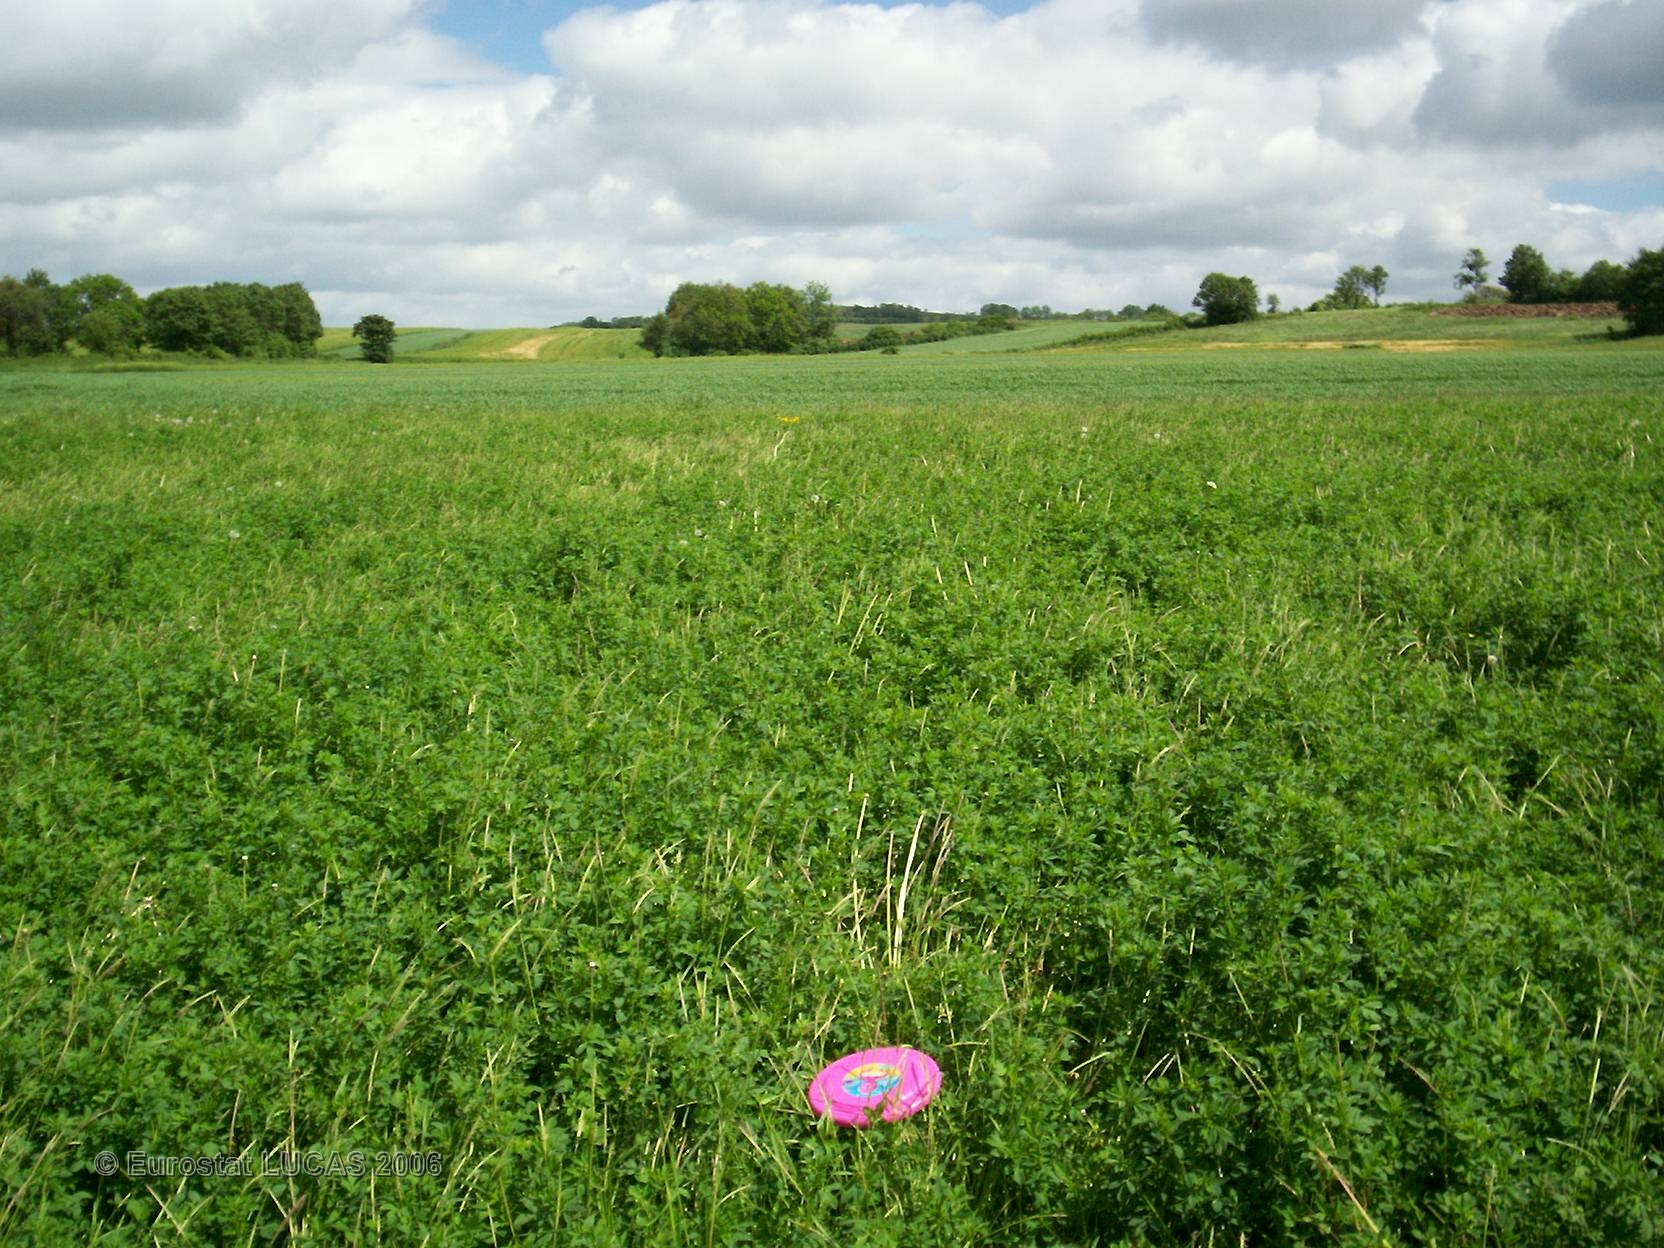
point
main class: Cropland
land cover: Lucerne
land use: Agriculture (excluding fallow land and kitchen gardens)
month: May
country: FR
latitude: 47.0471
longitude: 4.6431
